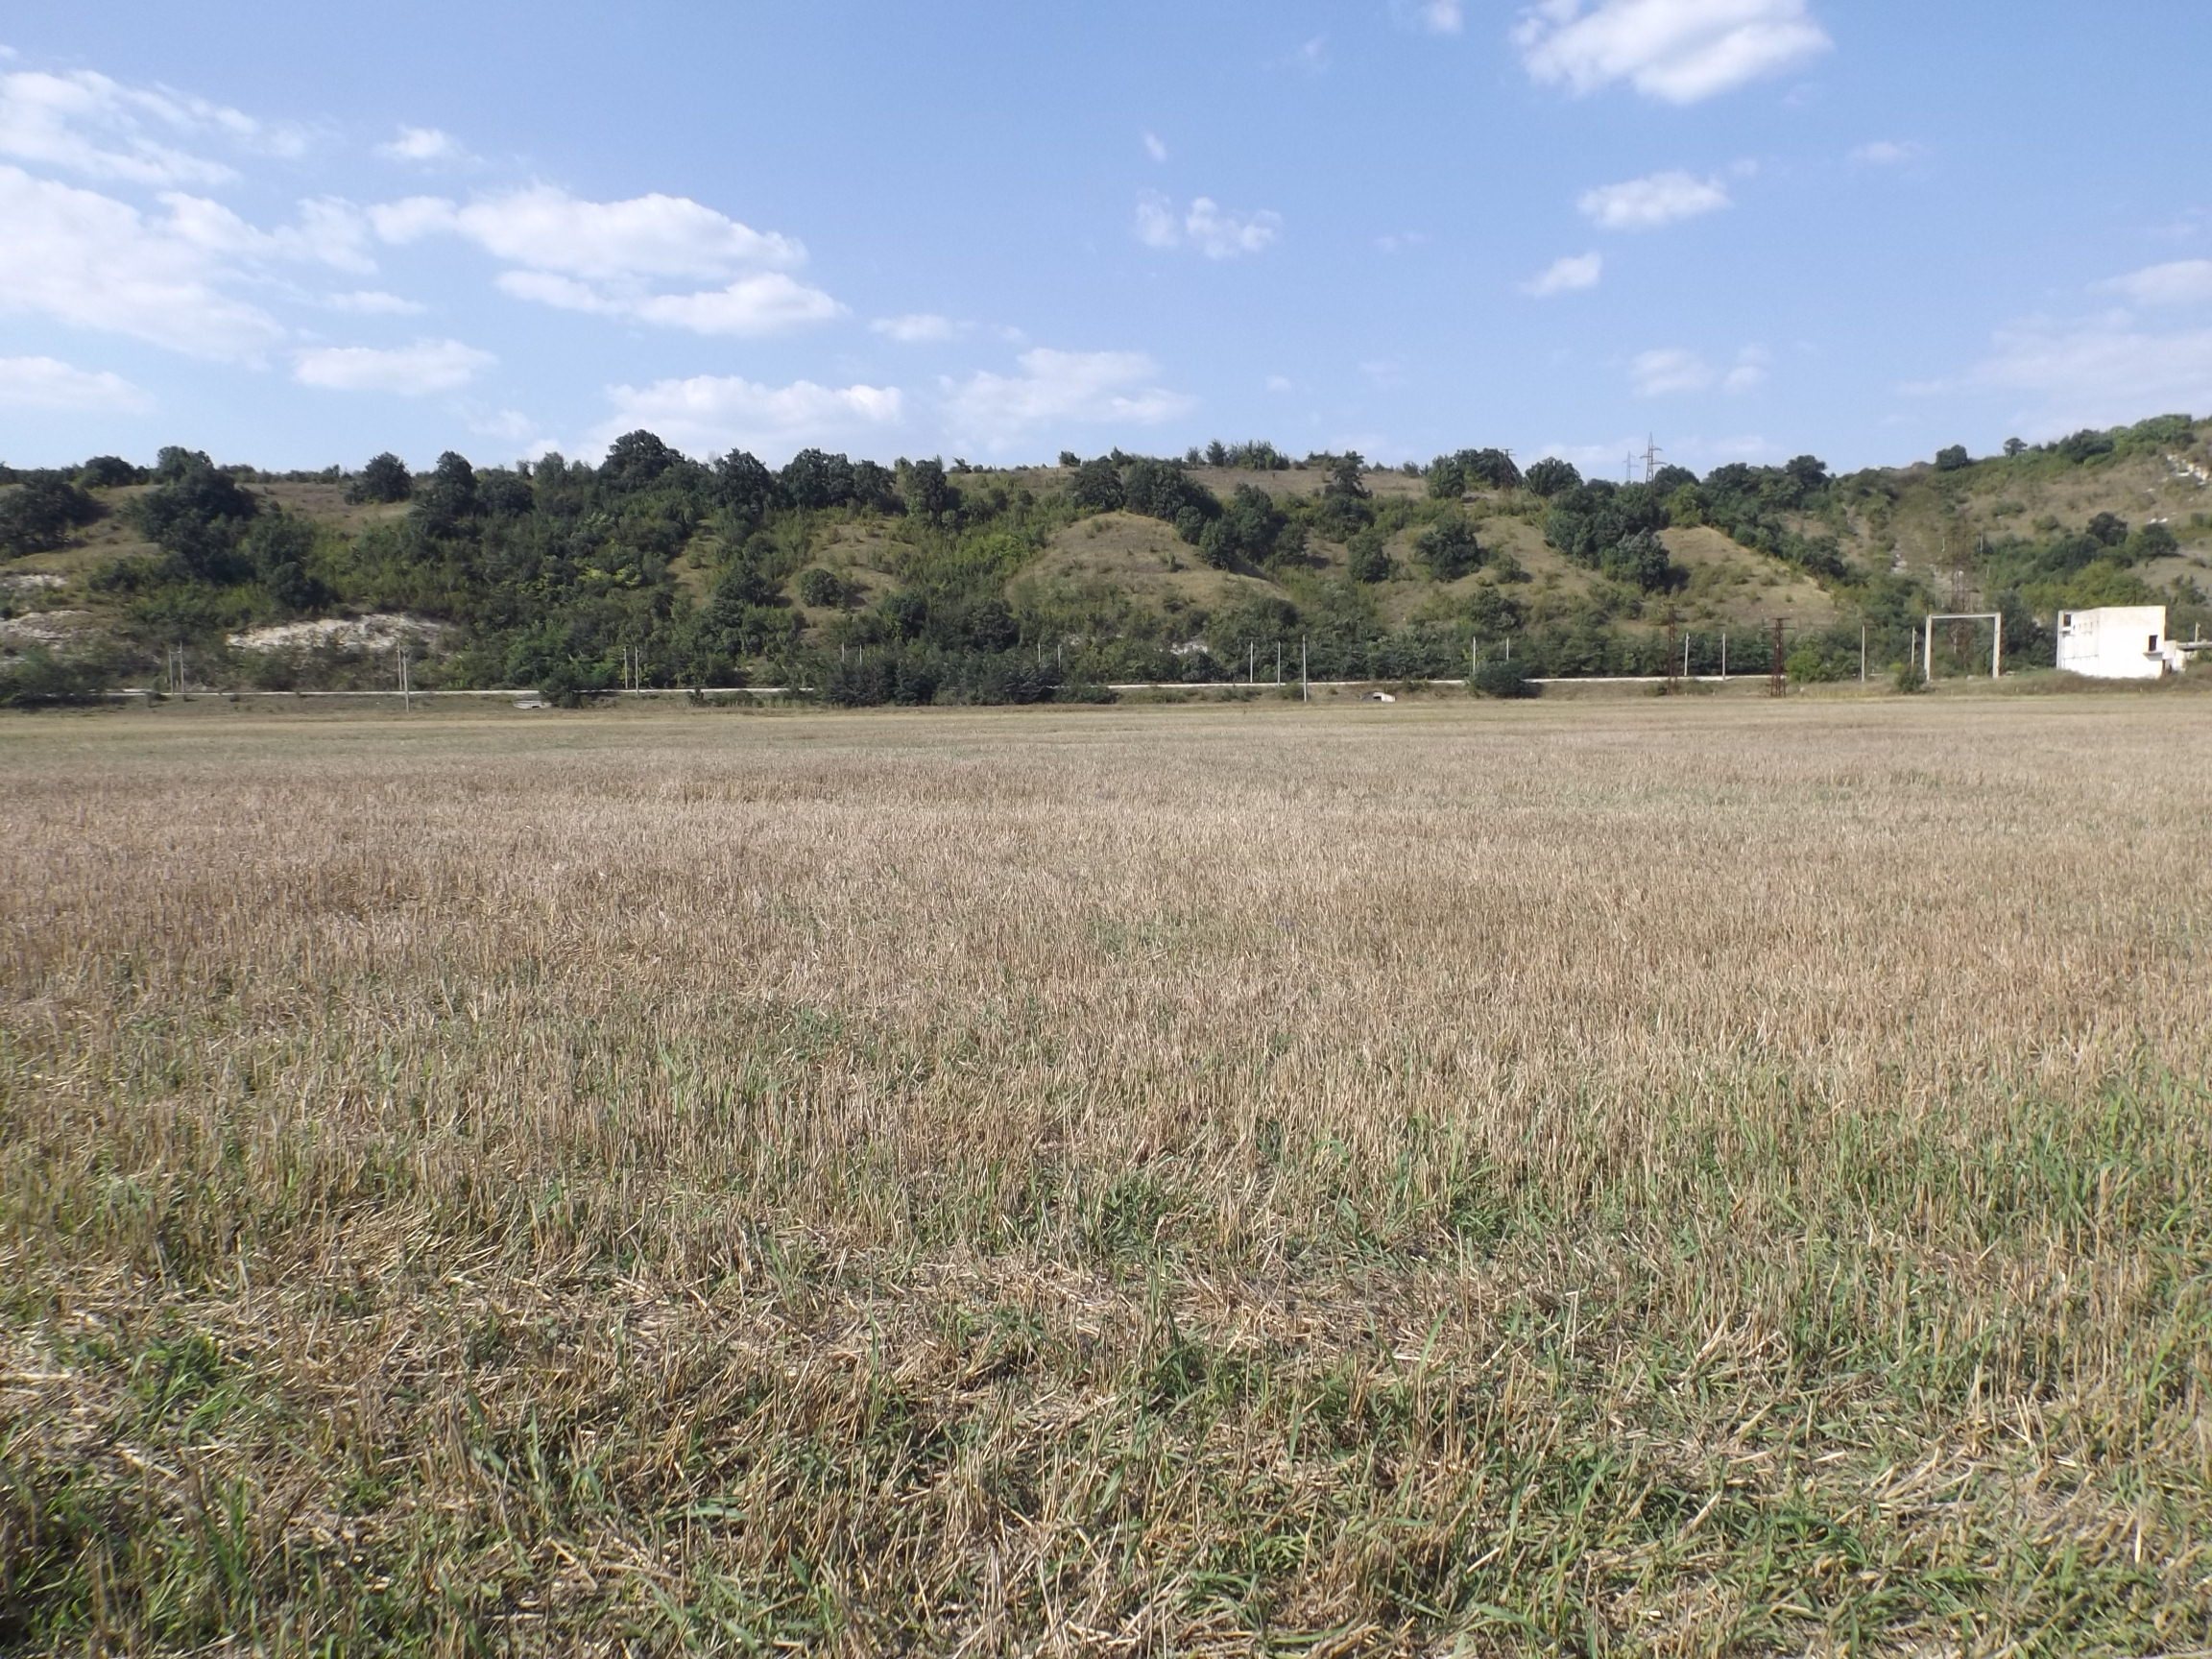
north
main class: Cropland
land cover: Common wheat
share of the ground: 25 - 50 %
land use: Agriculture (excluding fallow land and kitchen gardens)
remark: Harvested field
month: August
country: BG
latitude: 43.0515
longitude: 27.3961
